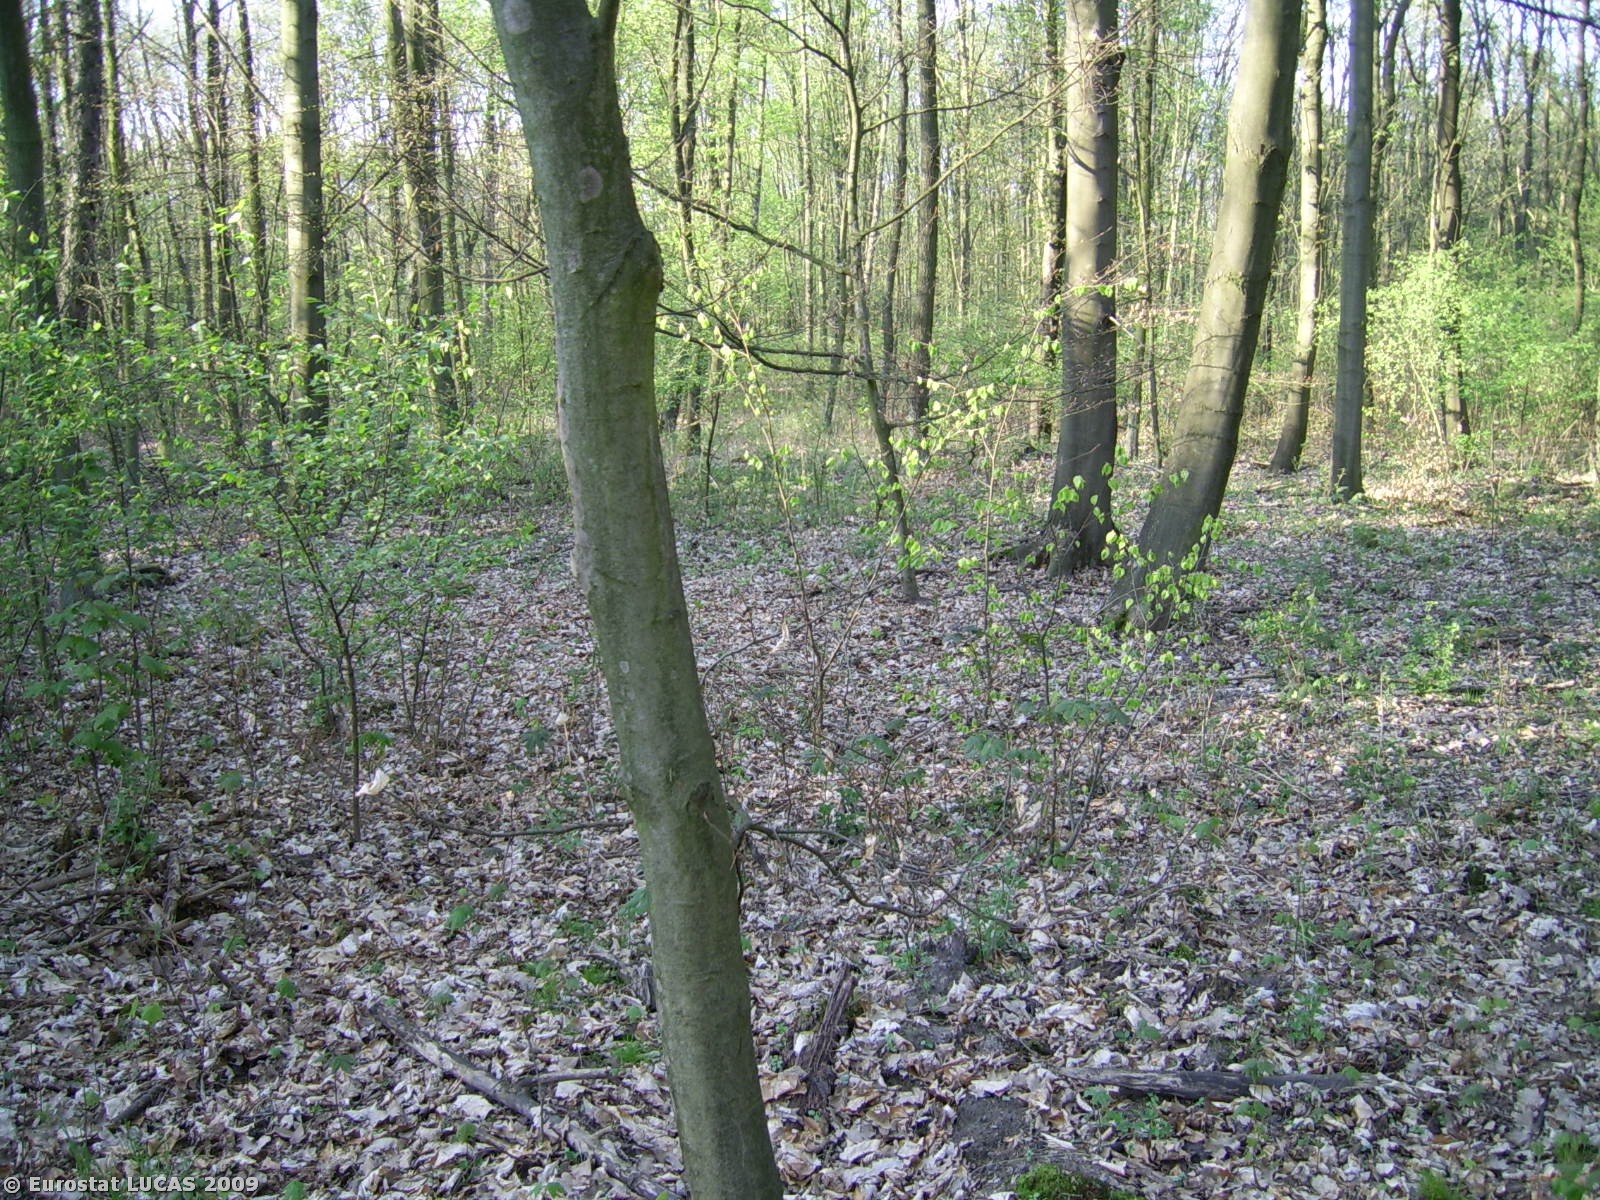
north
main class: Woodland
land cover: Mixed woodland
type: hemiboreal forest and nemoral coniferous forest and mixed broadleaved-coniferous forest
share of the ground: > 75 %
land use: Forestry
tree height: > 5 m
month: April
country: PL
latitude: 52.2662
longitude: 16.9110
